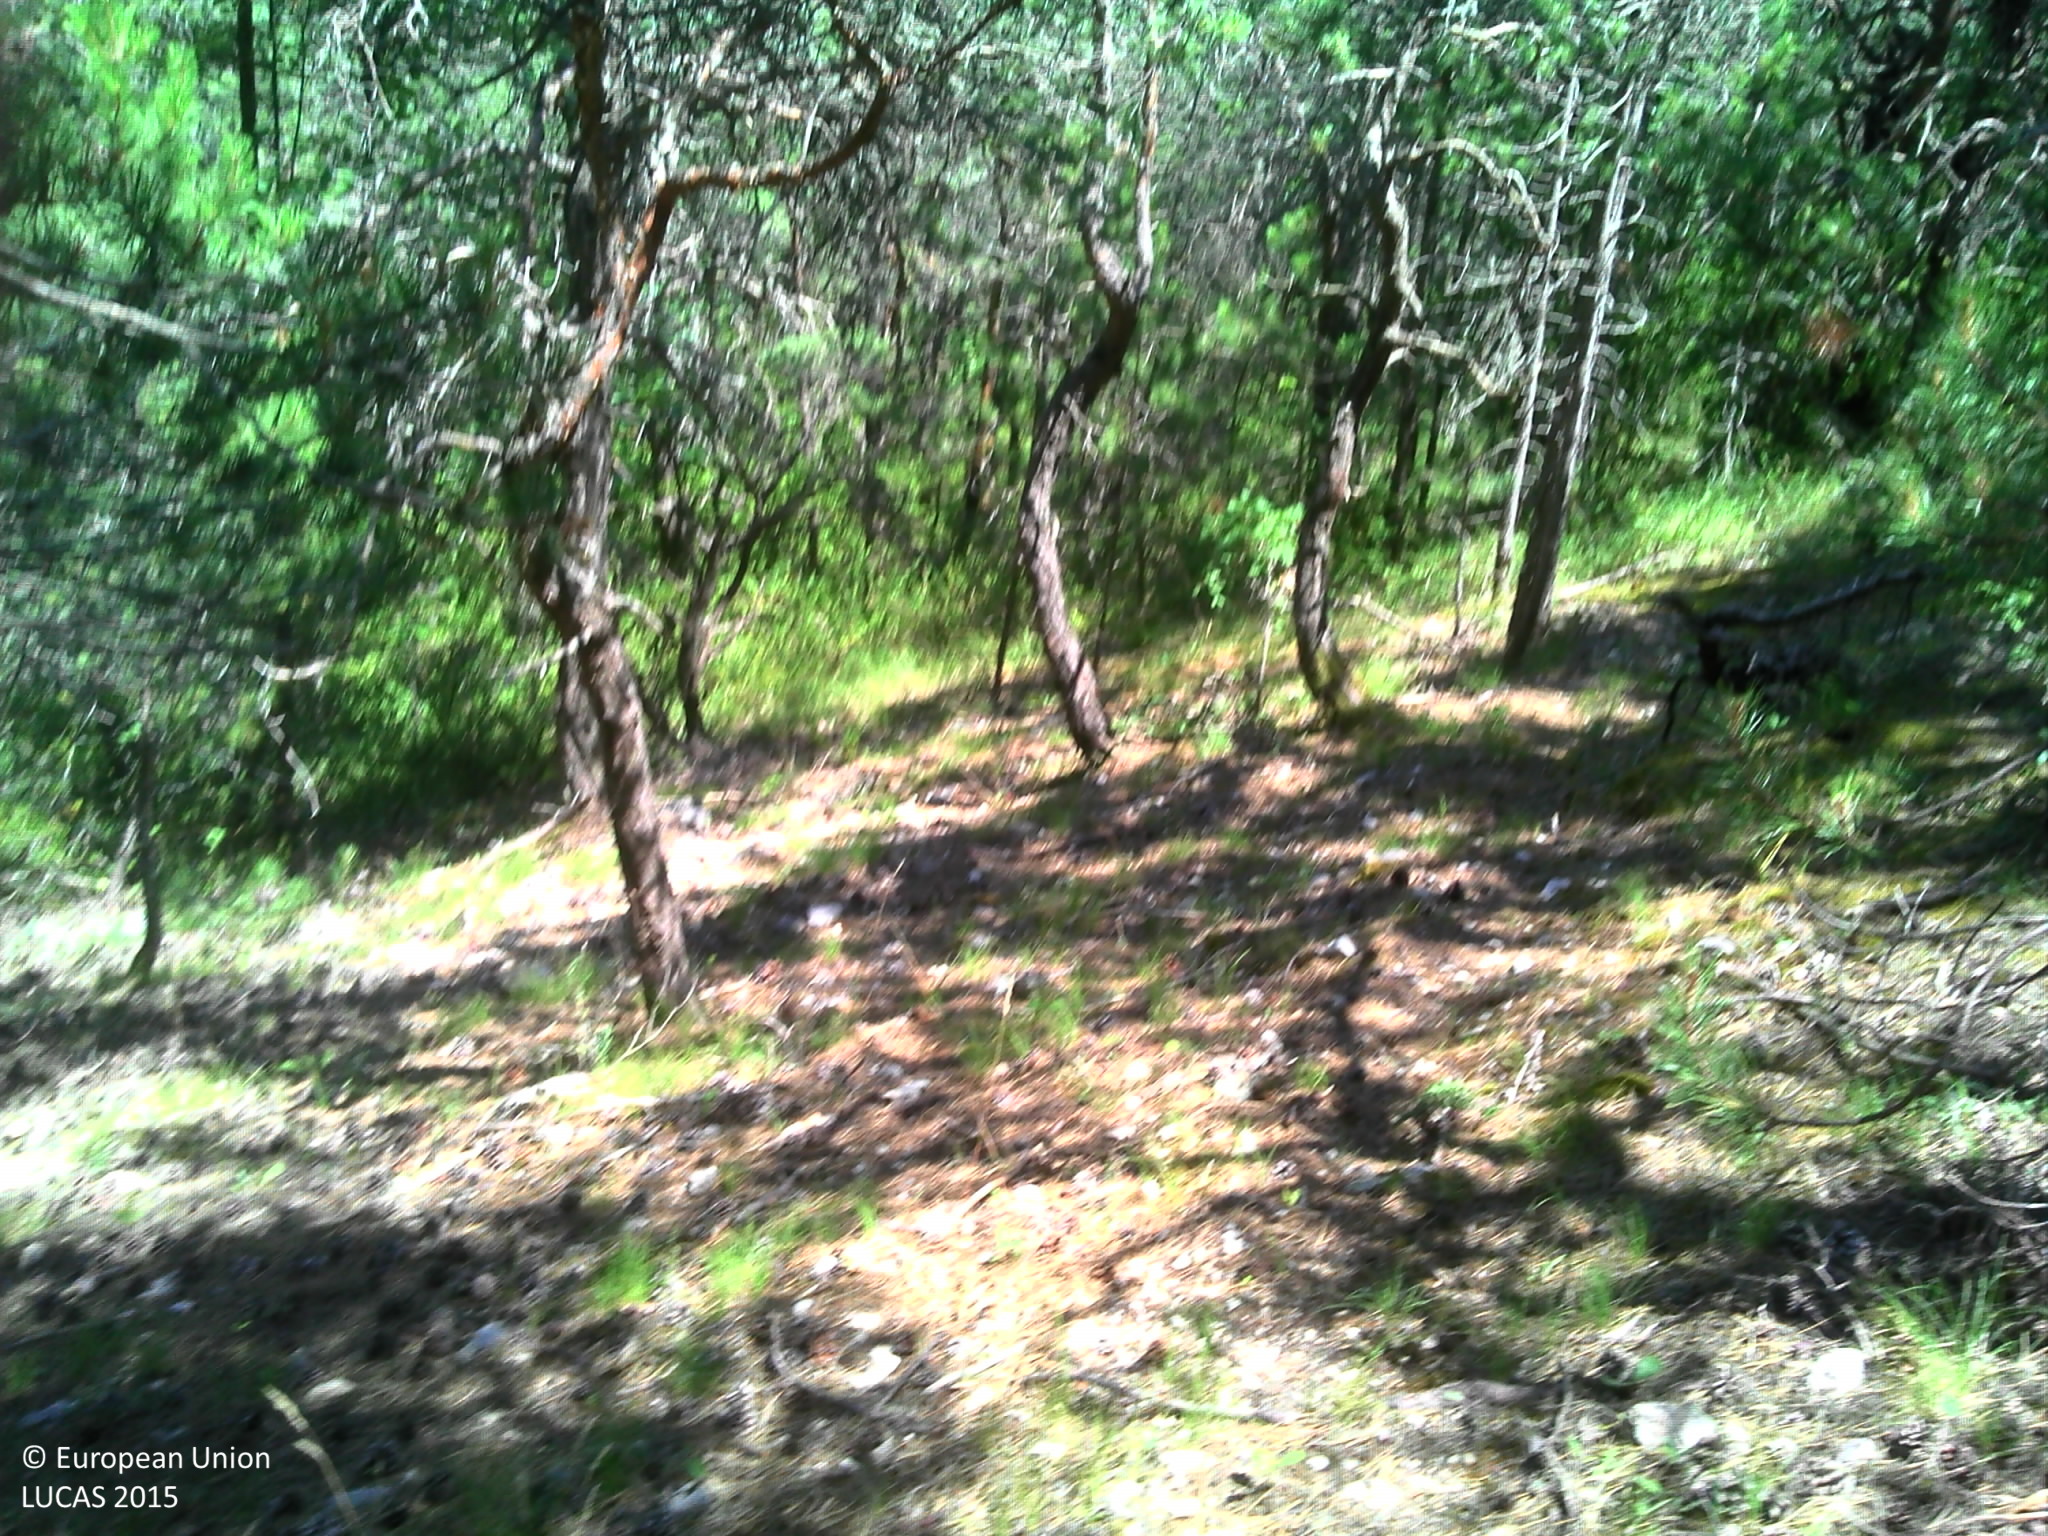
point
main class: Woodland
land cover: Pine dominated coniferous woodland
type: coniferous forest of the mediterranean region
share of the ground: > 75 %
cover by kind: coniferous forest trees 100 %
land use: Forestry
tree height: > 5 m
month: July
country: FR
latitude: 44.8047
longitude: 5.3157
